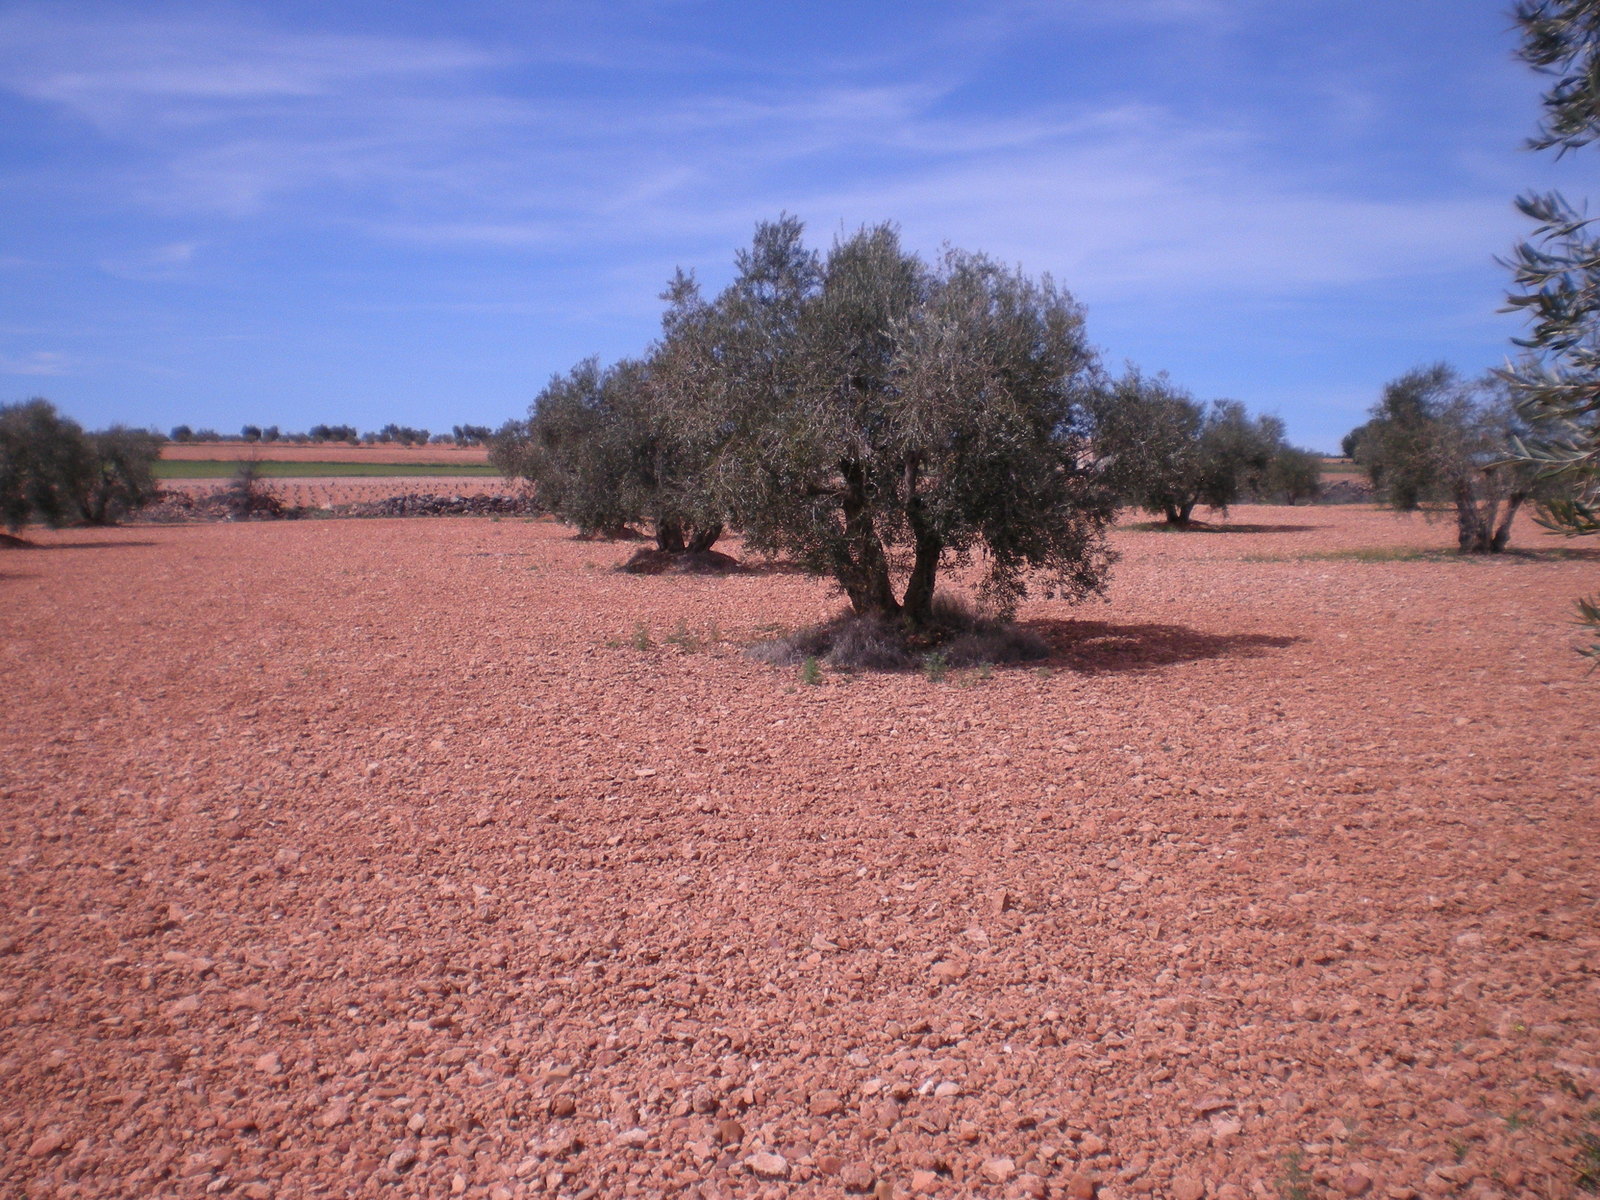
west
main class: Cropland
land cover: Olive groves
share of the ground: 10 - 25 %
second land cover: Other bare soil
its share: > 75 %
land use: Agriculture (excluding fallow land and kitchen gardens)
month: March
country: ES
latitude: 39.0181
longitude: -3.2374
